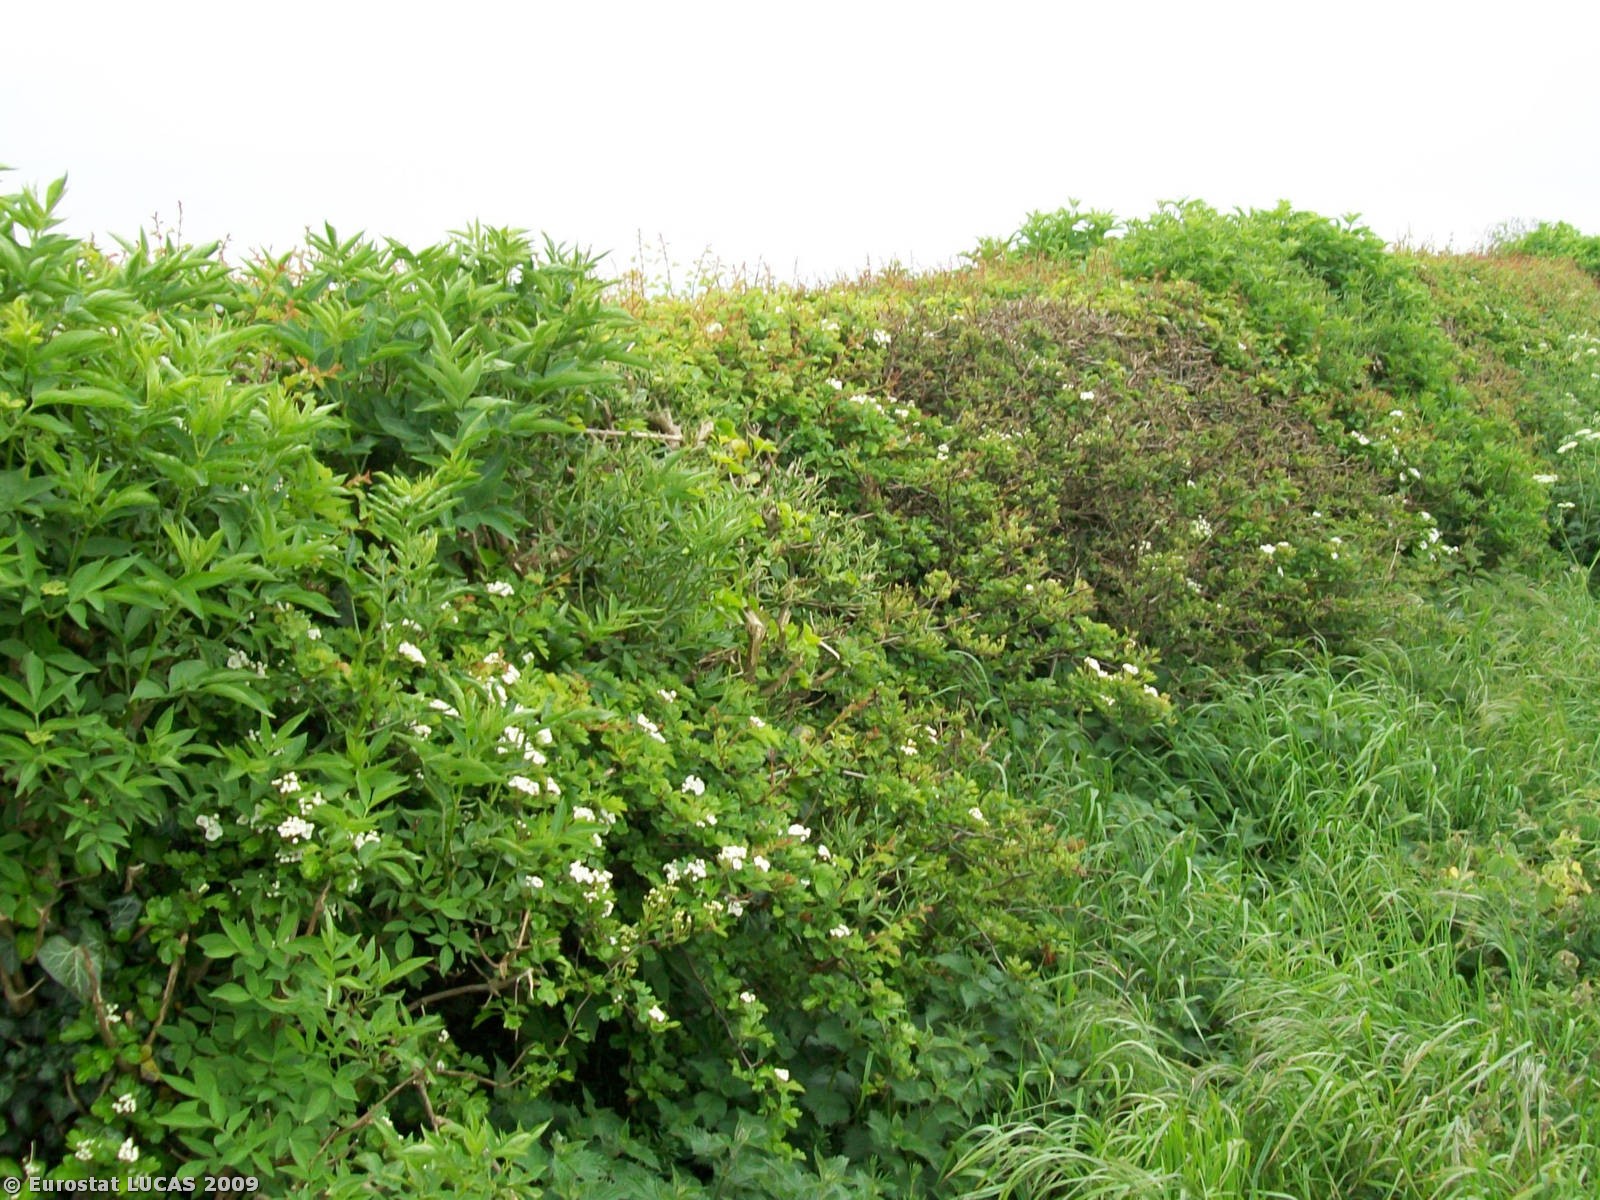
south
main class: Cropland
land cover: Common wheat
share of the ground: > 75 %
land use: Agriculture (excluding fallow land and kitchen gardens)
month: May
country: GB
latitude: 52.8035
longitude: -0.8556
